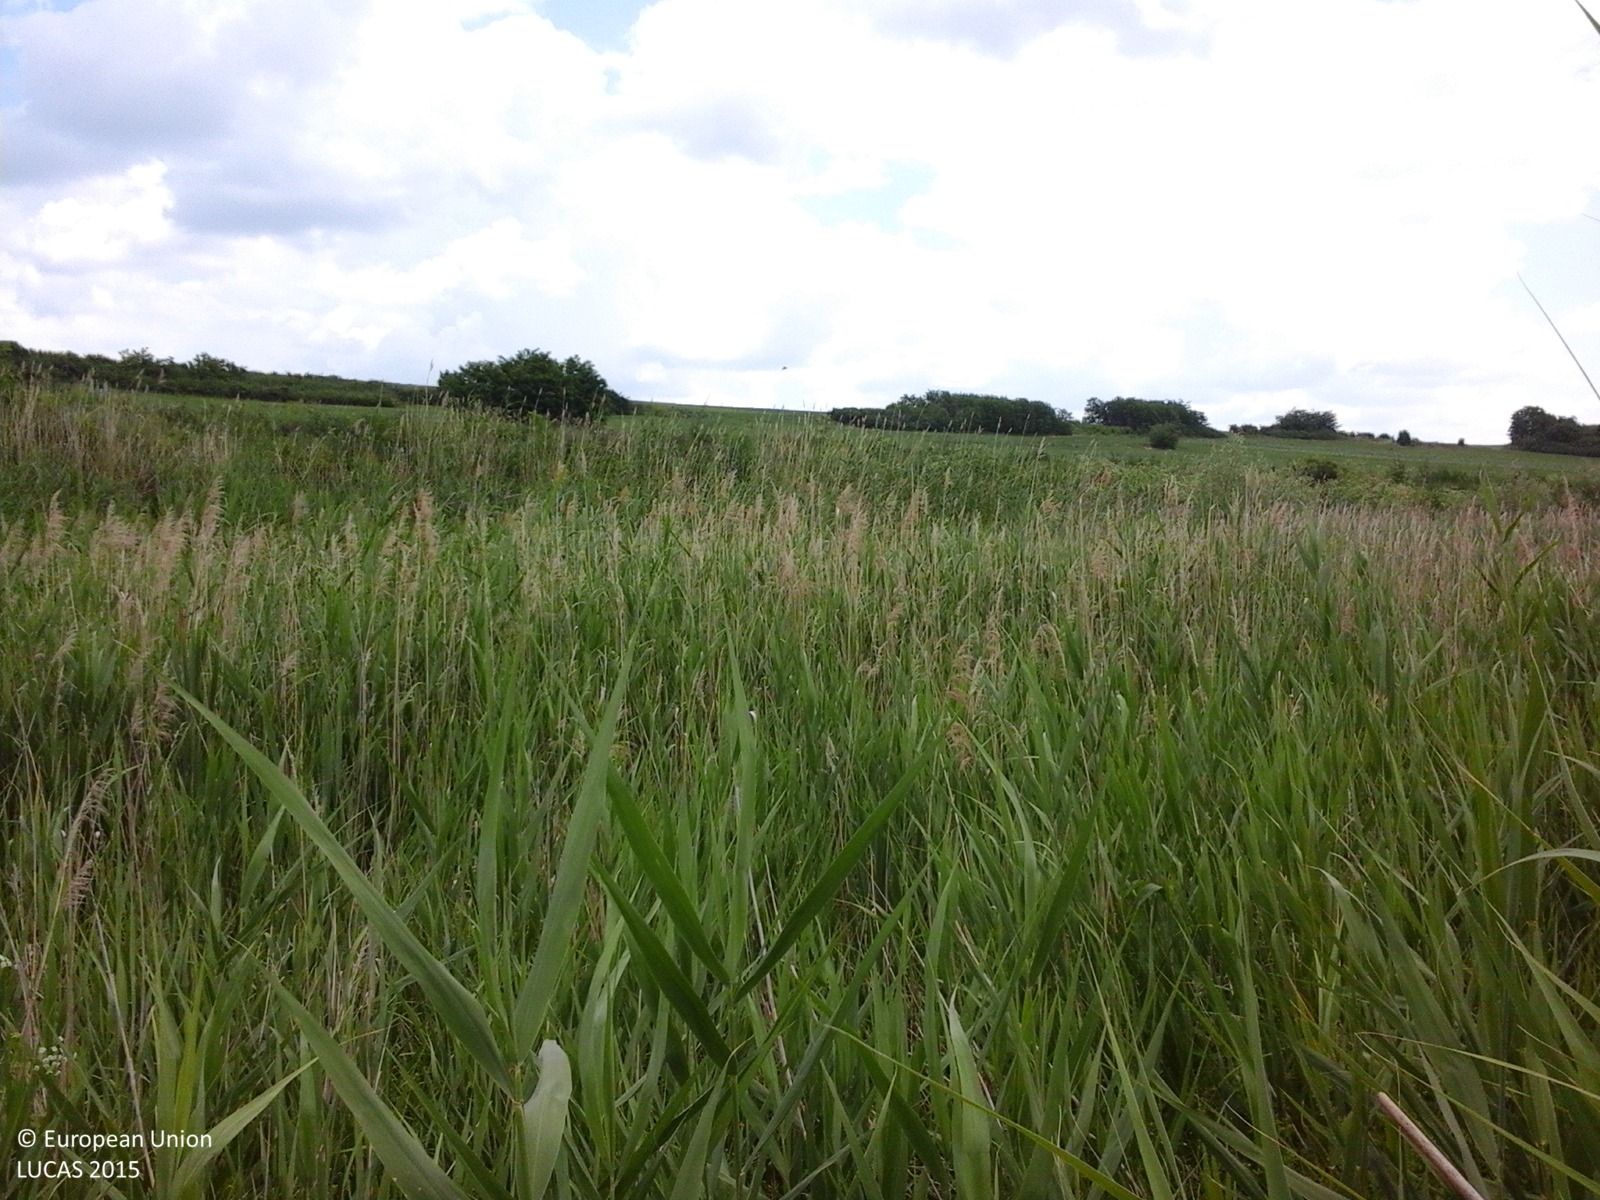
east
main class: Grassland
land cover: Spontaneously vegetated surfaces
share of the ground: > 75 %
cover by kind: herbaceous plants 95 %, shrubs 5 %
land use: Fallow land
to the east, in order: Spontaneously vegetated surfaces; Soya; Shrubland with sparse tree cover; Grass margins; Tracks; Grass margins
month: June
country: RO
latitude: 47.6322
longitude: 27.0746
